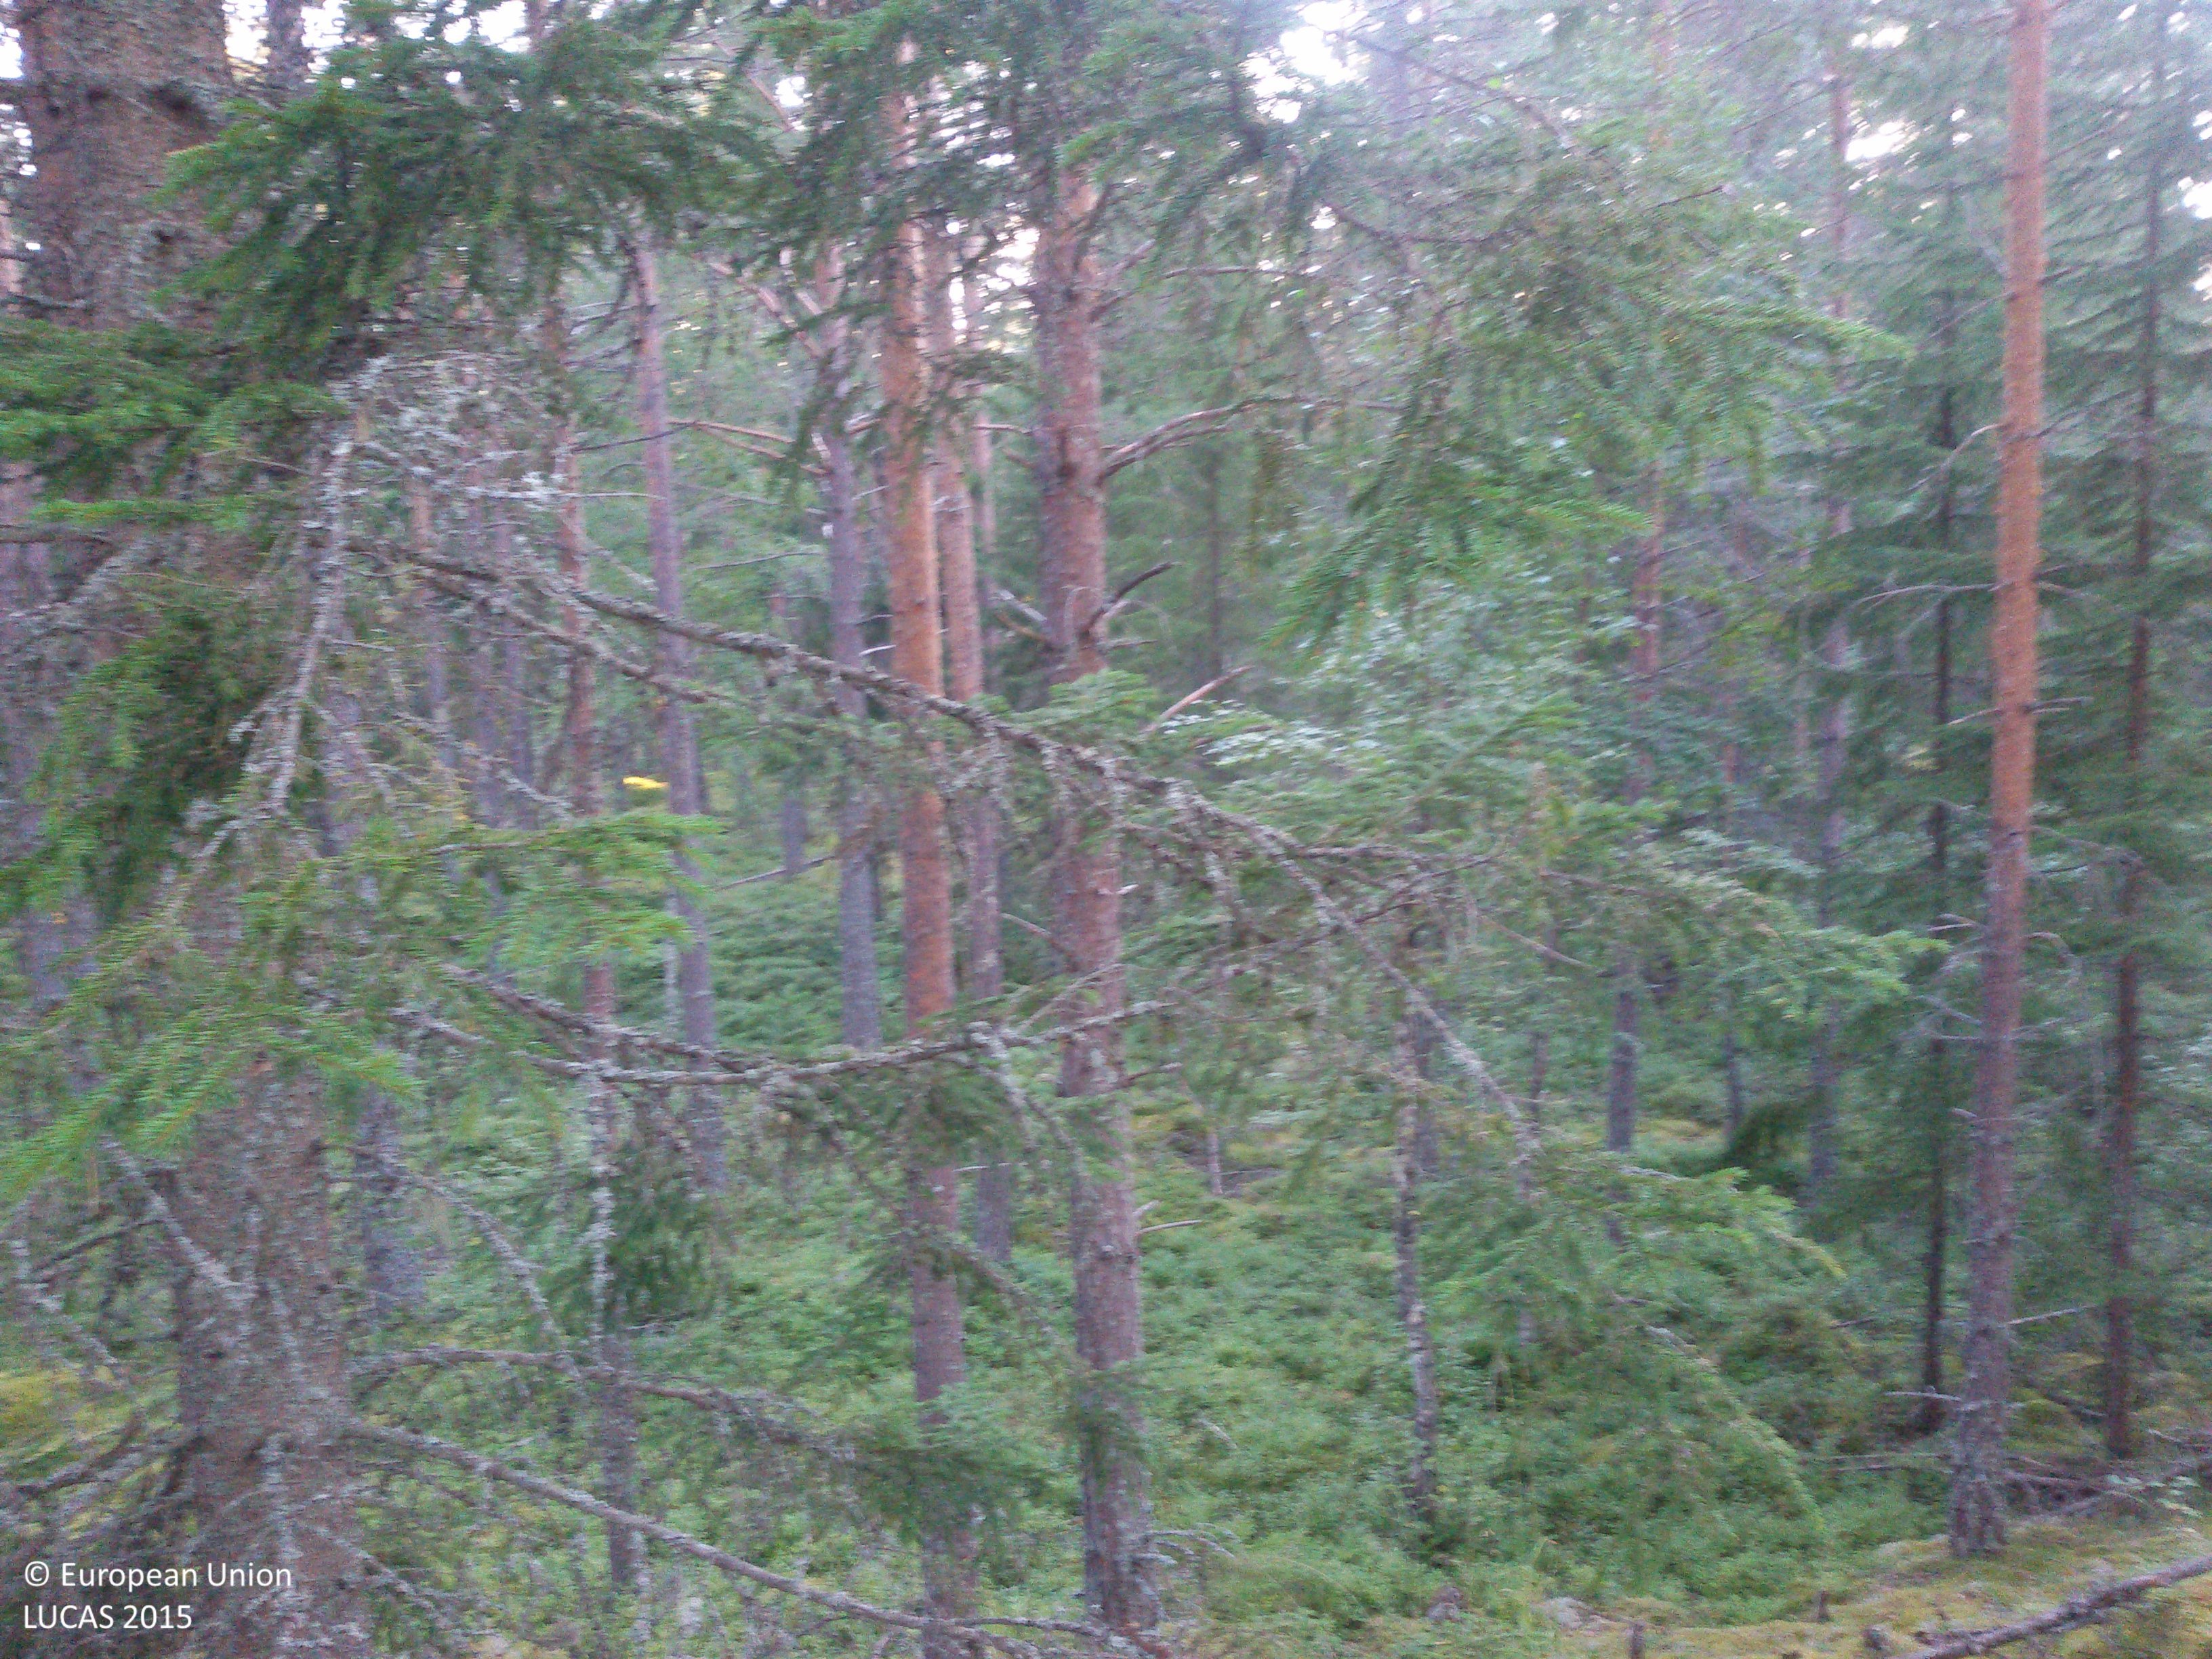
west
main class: Woodland
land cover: Pine dominated coniferous woodland
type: boreal forest
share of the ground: 50 - 75 %
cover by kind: coniferous forest trees 70 %, lichens and mosses 25 %, herbaceous plants 5 %
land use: Forestry
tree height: > 5 m
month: August
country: SE
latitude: 60.7080
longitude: 15.4289
